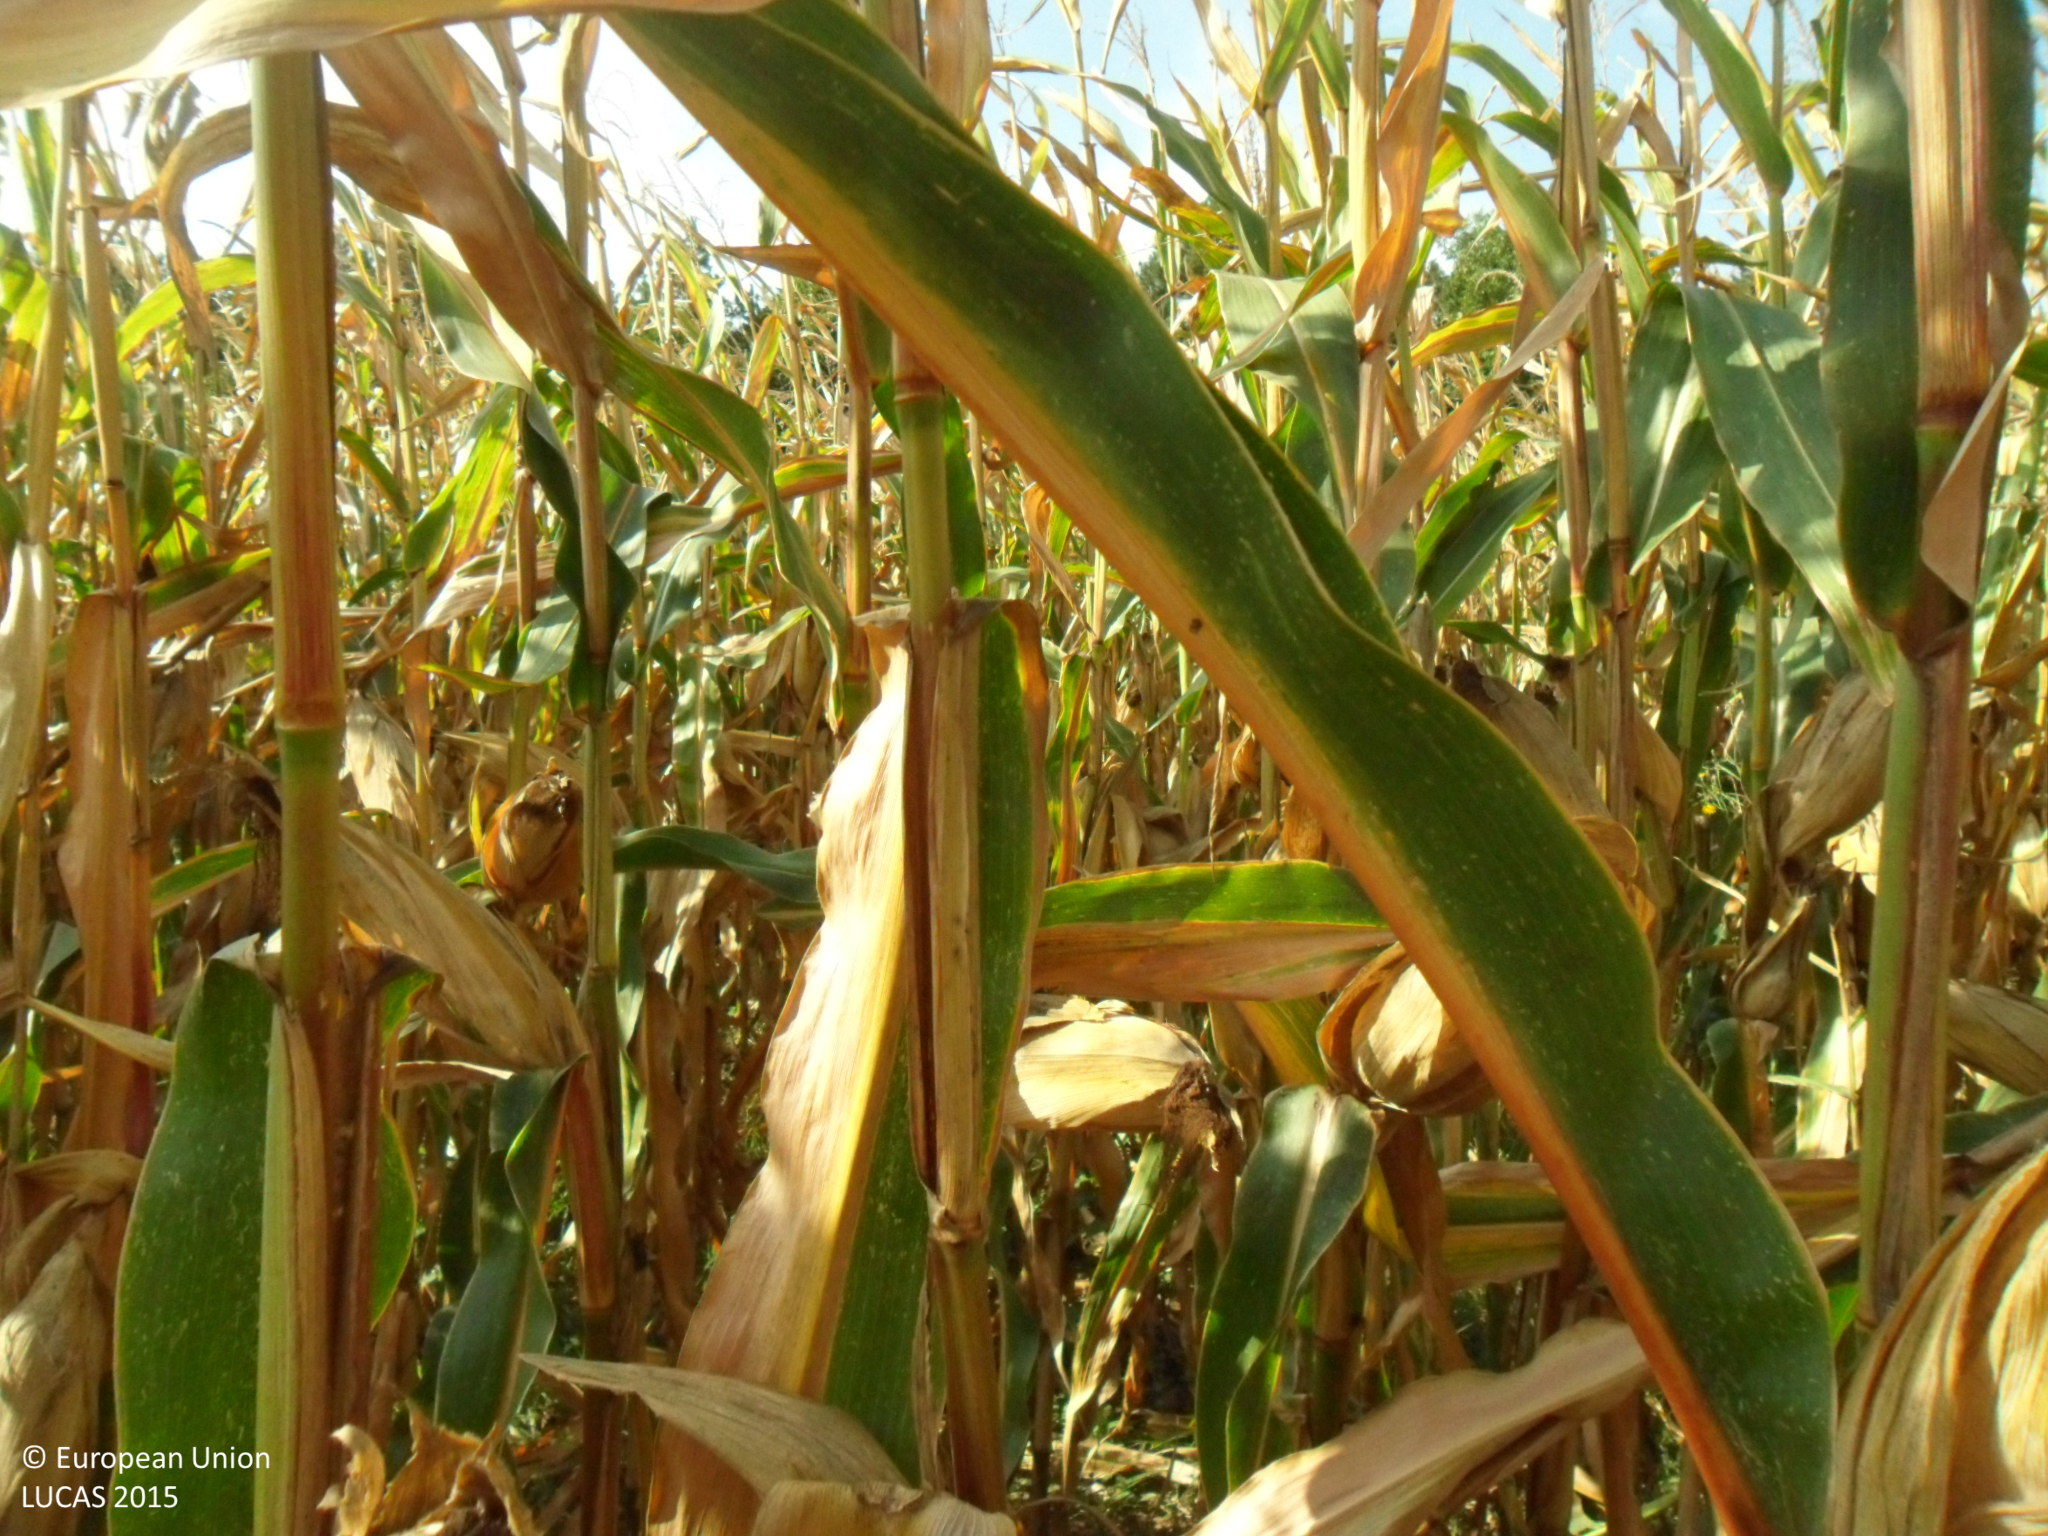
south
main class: Cropland
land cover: Maize
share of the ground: > 75 %
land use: Agriculture (excluding fallow land and kitchen gardens)
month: September
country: BG
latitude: 43.6152
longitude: 26.2199
